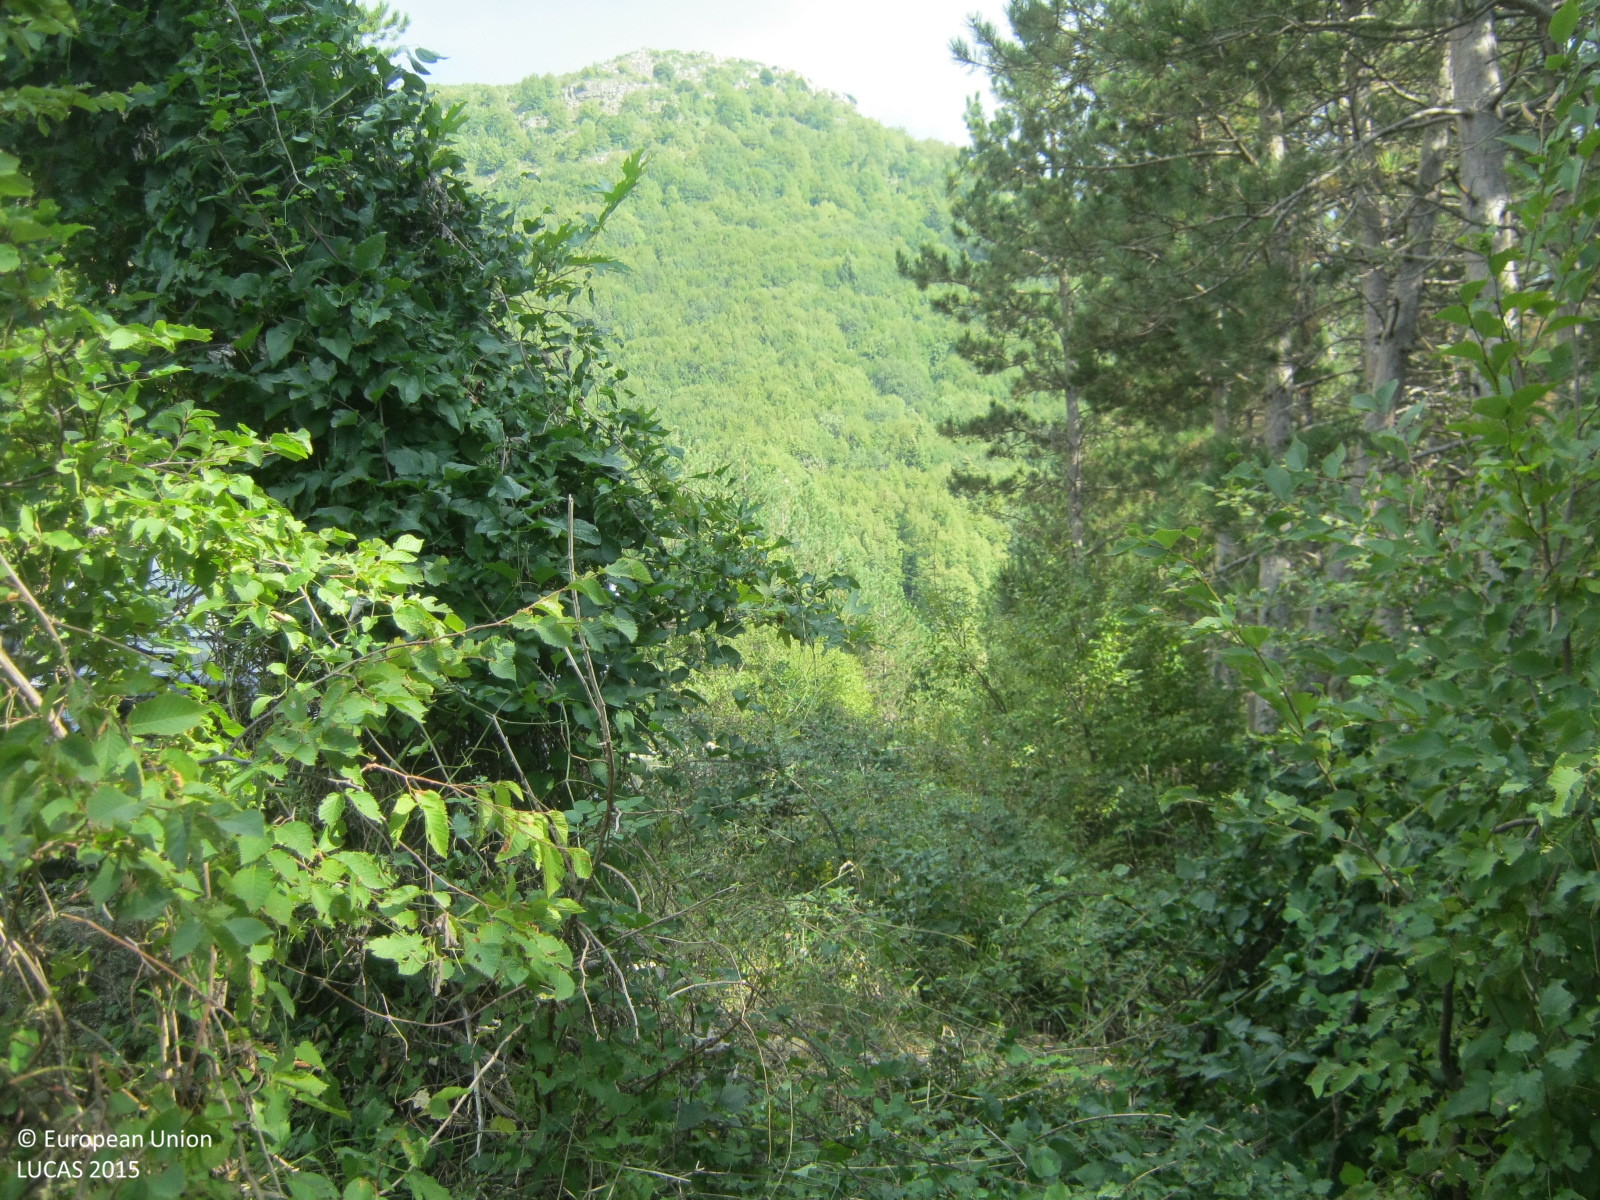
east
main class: Woodland
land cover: Pine dominated mixed woodland
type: coniferous forest of the mediterranean region
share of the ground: > 75 %
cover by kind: coniferous forest trees 70 %, broadleaved forest trees 25 %, shrubs 5 %
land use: Semi-natural and natural areas not in use
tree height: > 5 m
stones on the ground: < 10 %
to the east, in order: Pine dominated mixed woodland; Tracks; Pine dominated mixed woodland
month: September
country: GR
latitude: 39.4146
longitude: 21.1158
